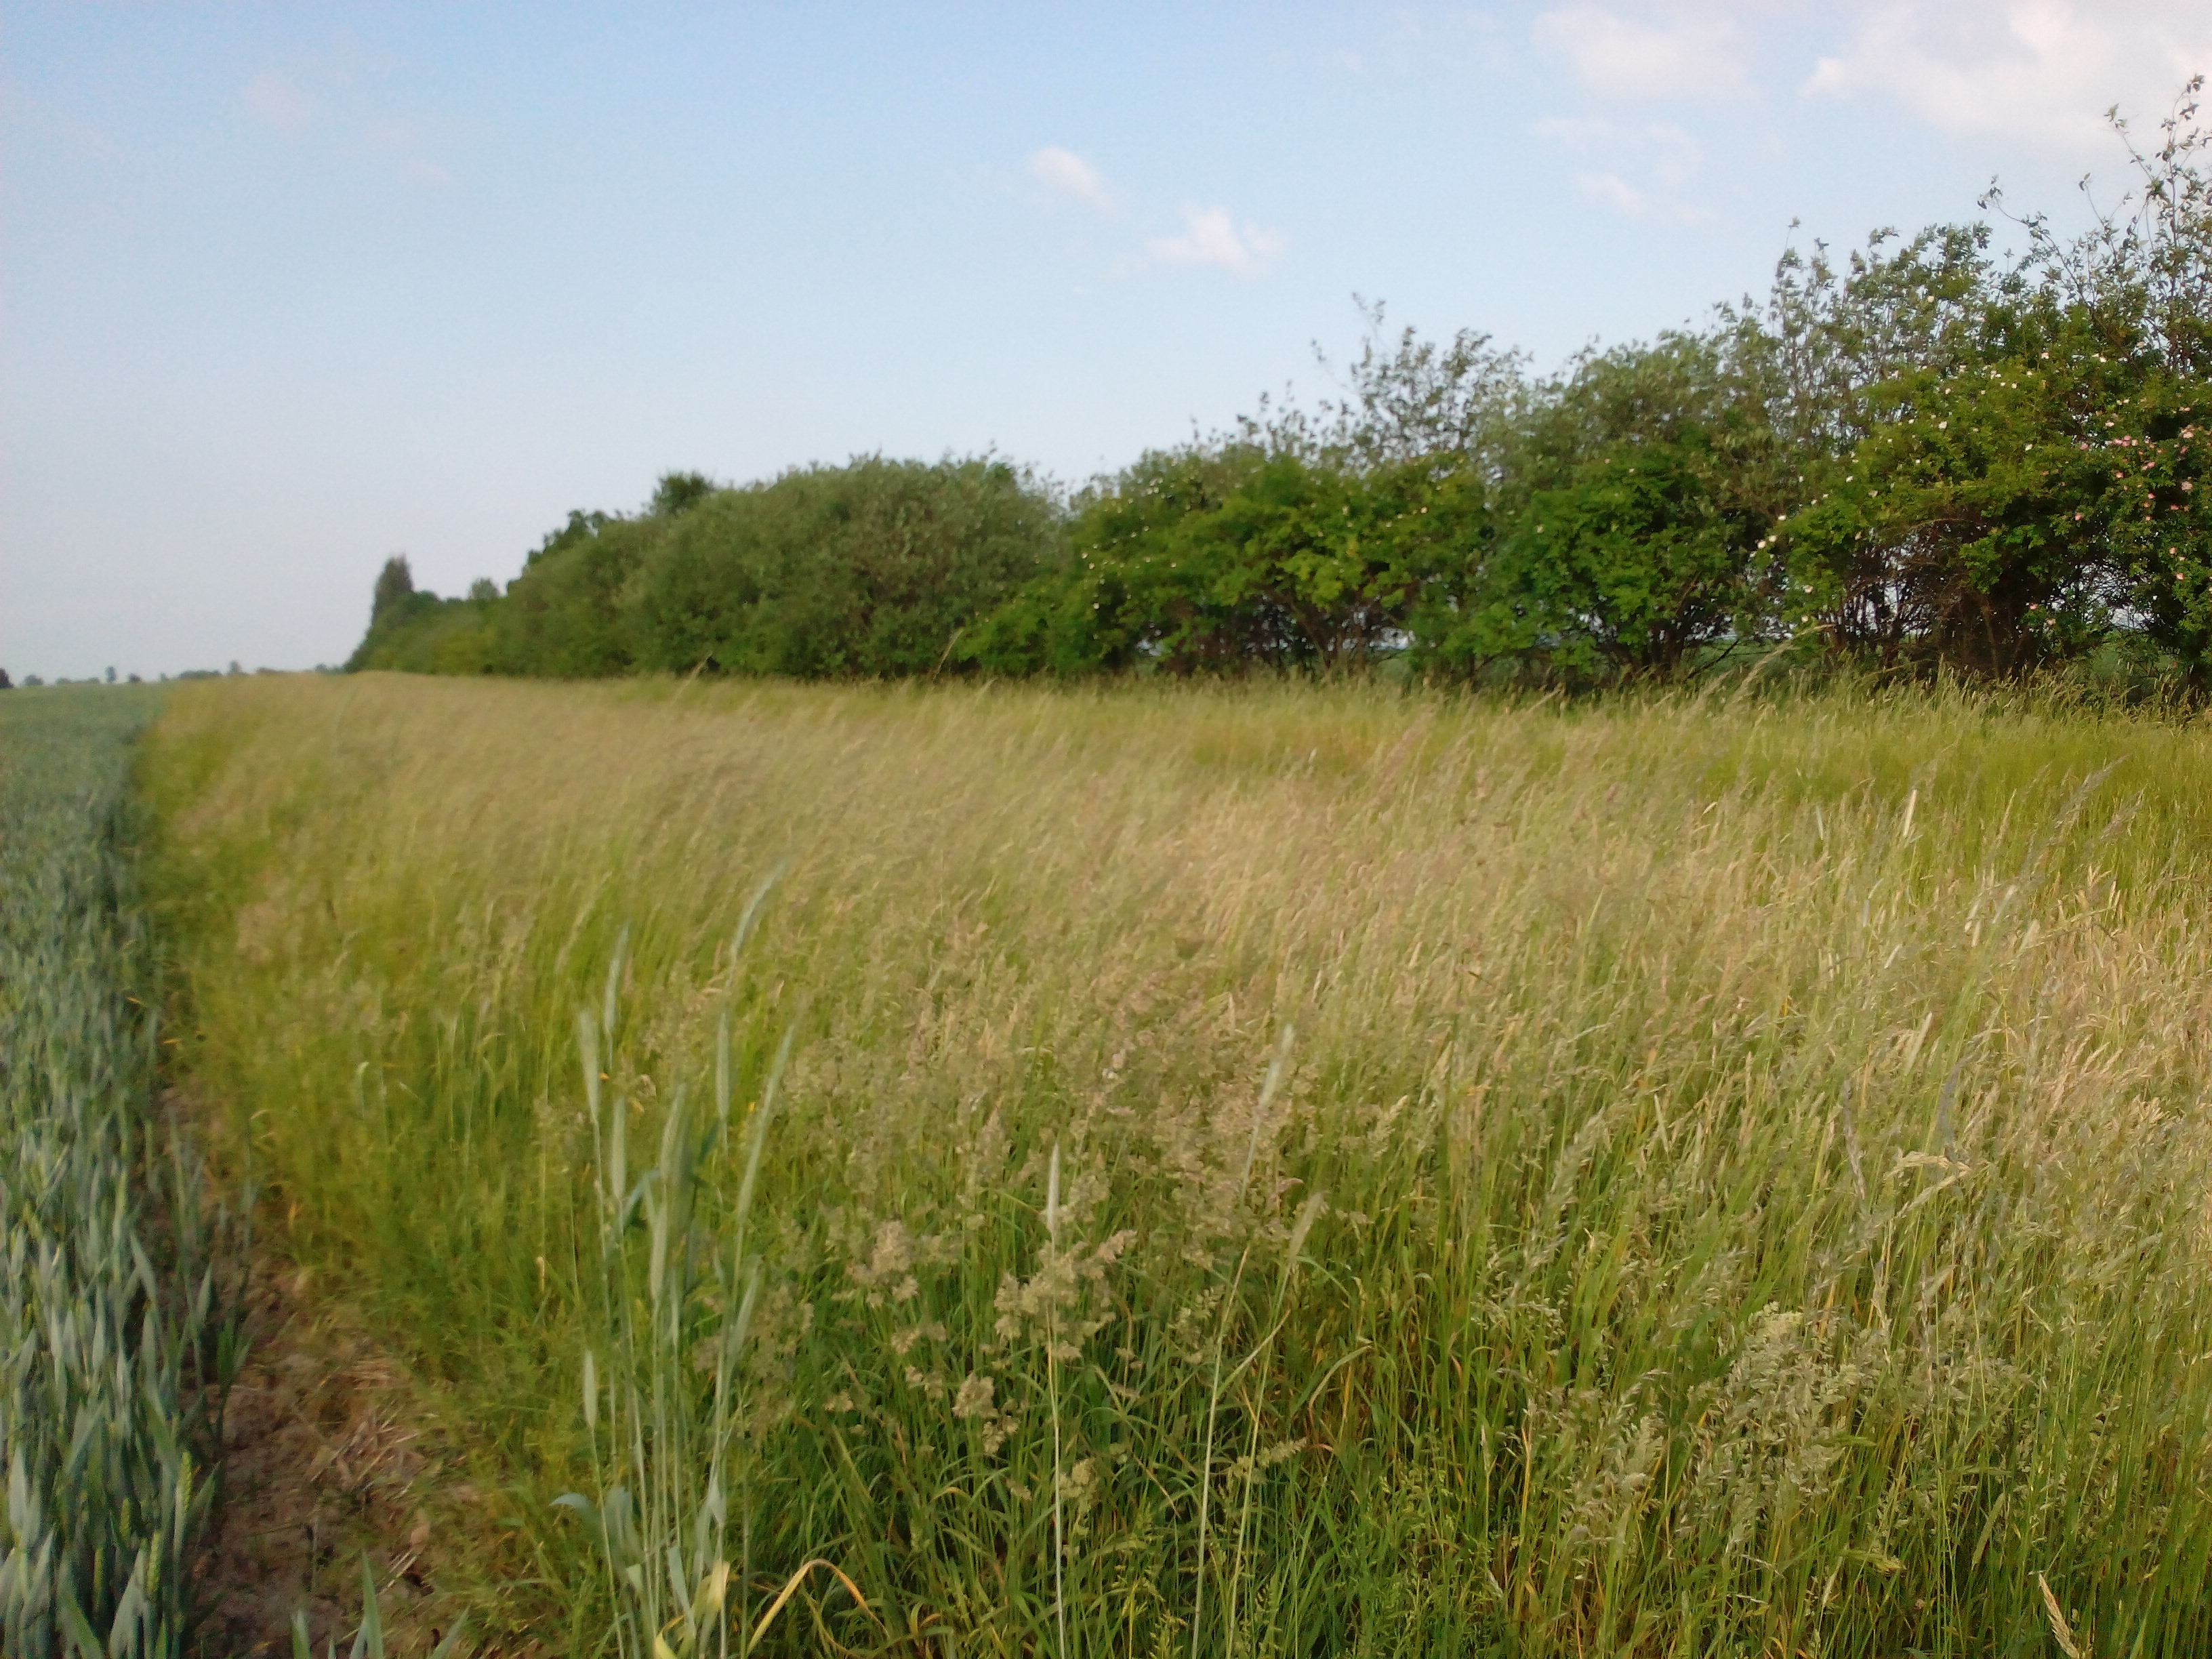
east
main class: Cropland
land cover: Common wheat
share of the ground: > 75 %
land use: Agriculture (excluding fallow land and kitchen gardens)
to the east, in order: Common wheat
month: June
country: DE
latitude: 50.9376
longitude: 10.6402
